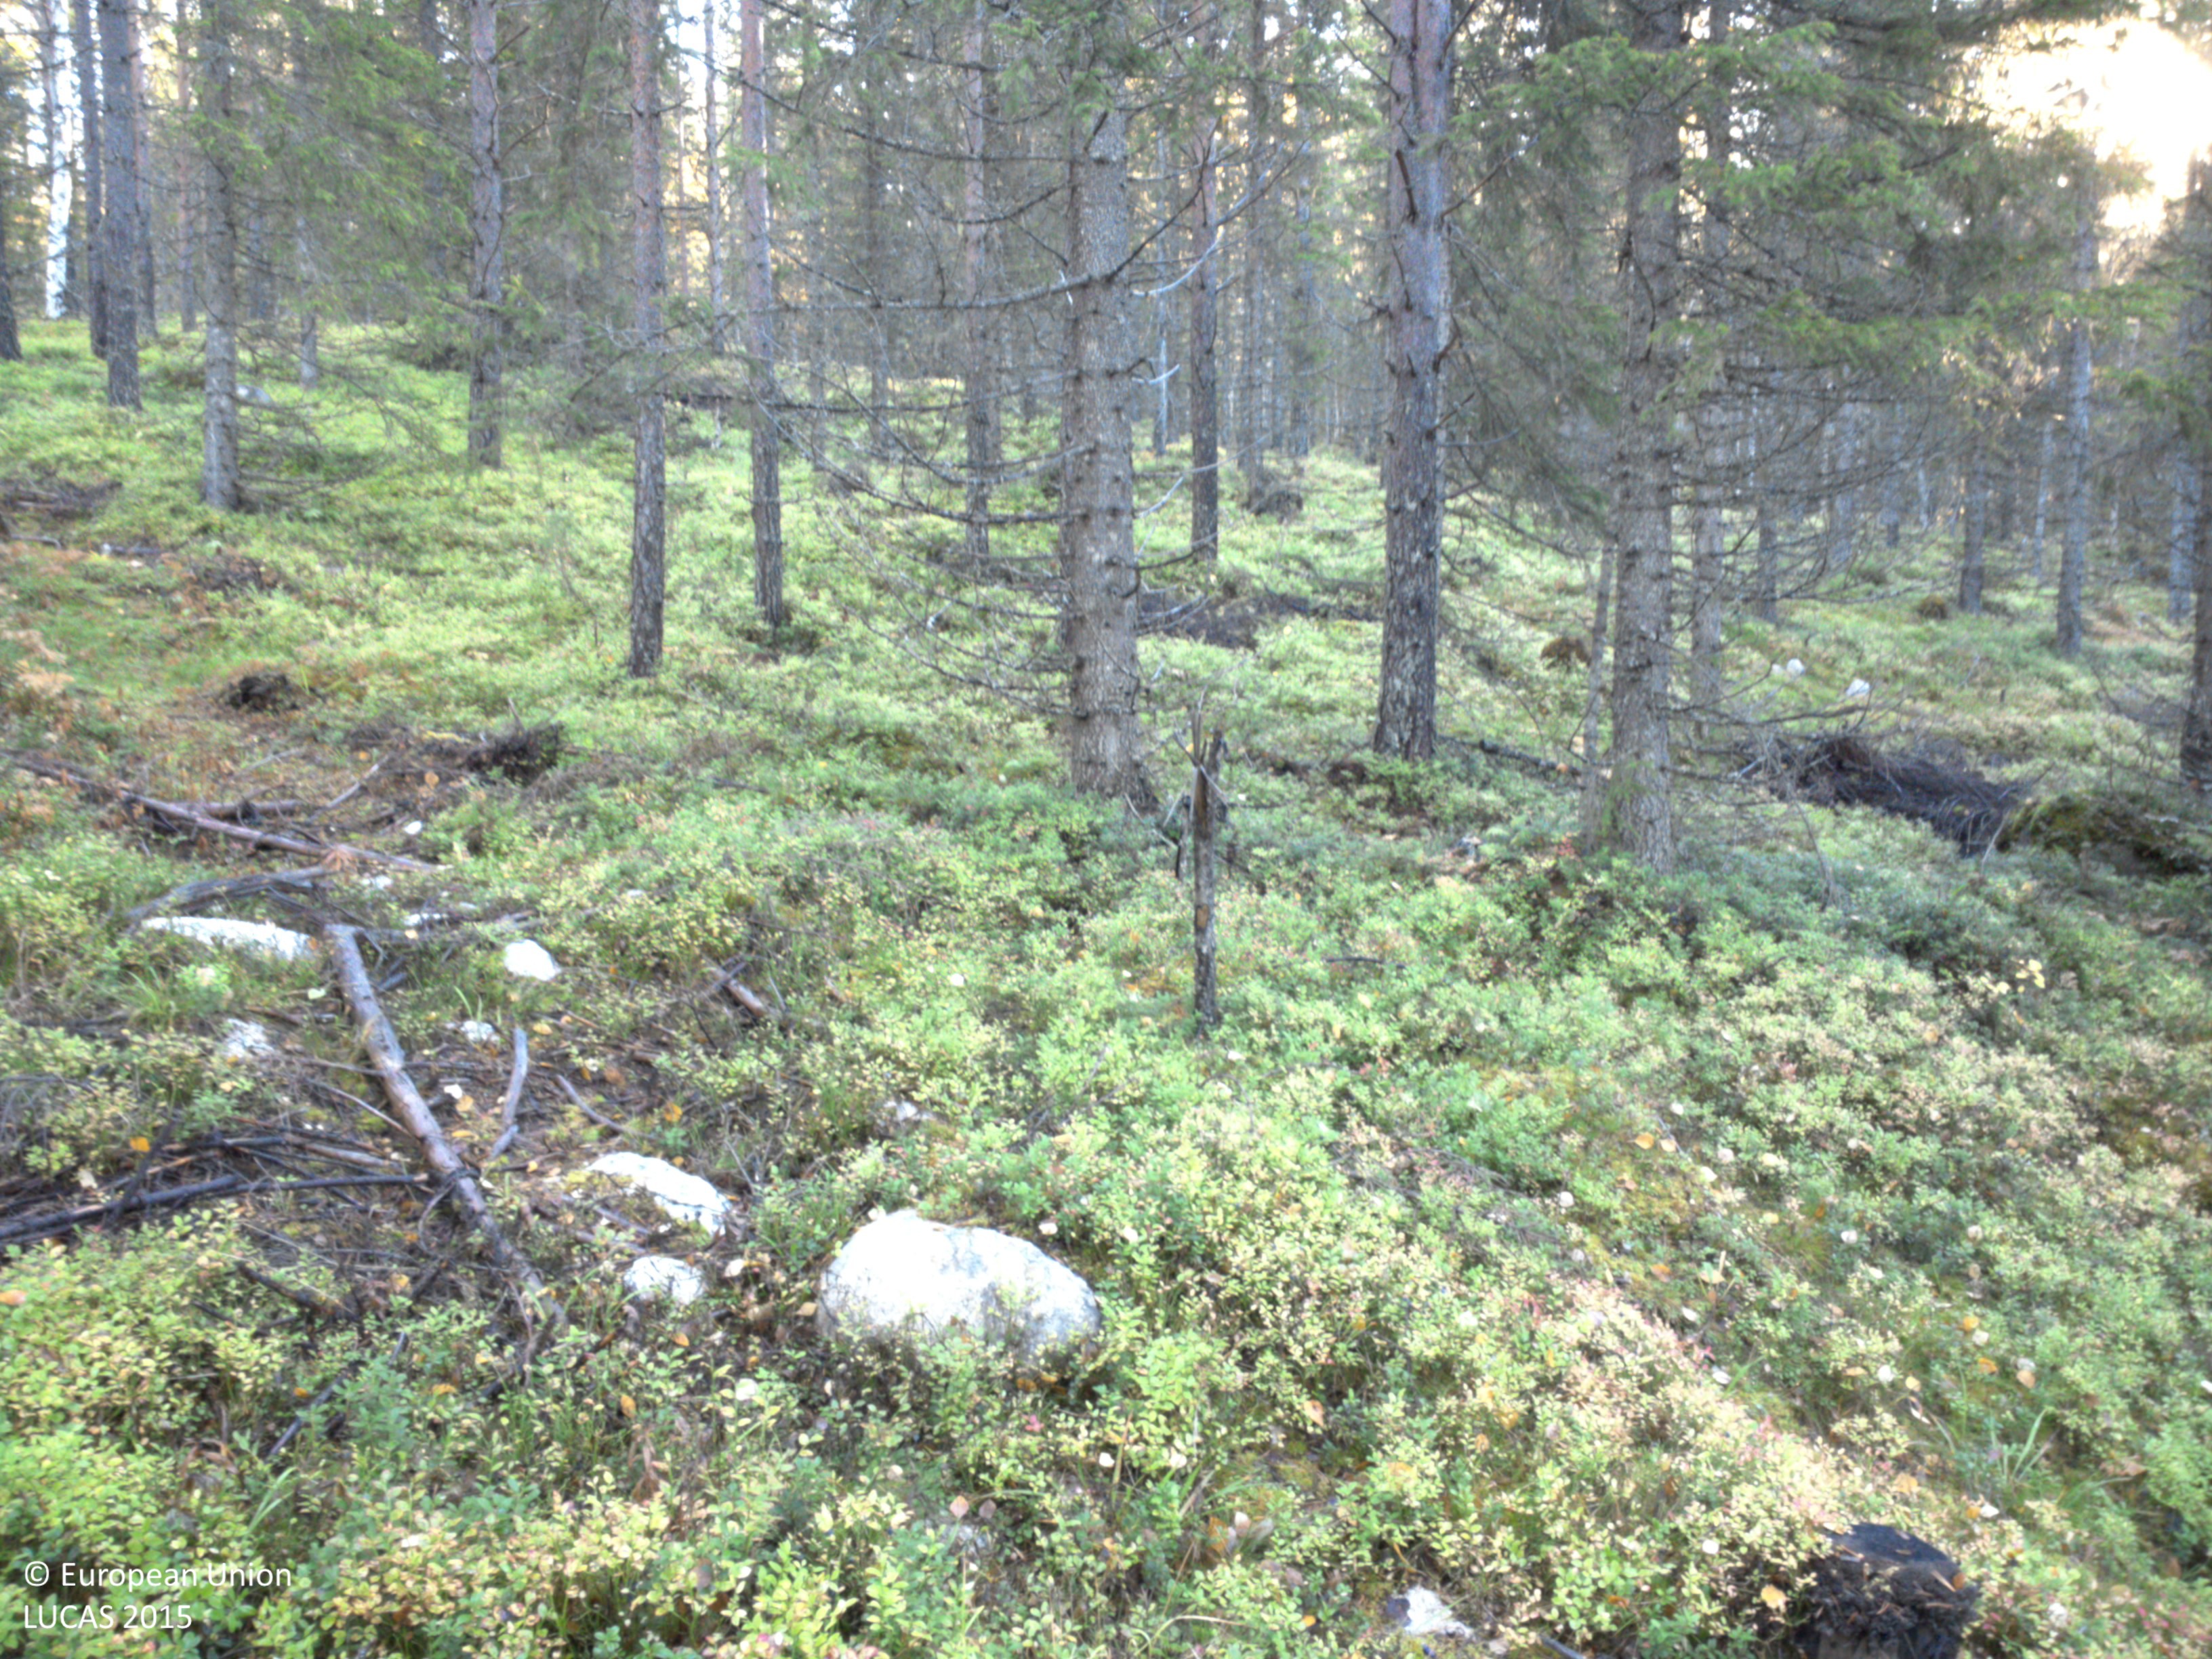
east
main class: Woodland
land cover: Other coniferous woodland
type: boreal forest
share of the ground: > 75 %
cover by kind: coniferous forest trees 75 %, shrubs 15 %, lichens and mosses 10 %
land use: Forestry
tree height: > 5 m
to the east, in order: Other coniferous woodland; Spruce dominated coniferous woodland; Other mixed woodland; Spruce dominated mixed woodland; Other mixed woodland; Other coniferous woodland
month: September
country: SE
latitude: 64.8358
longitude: 18.9668
